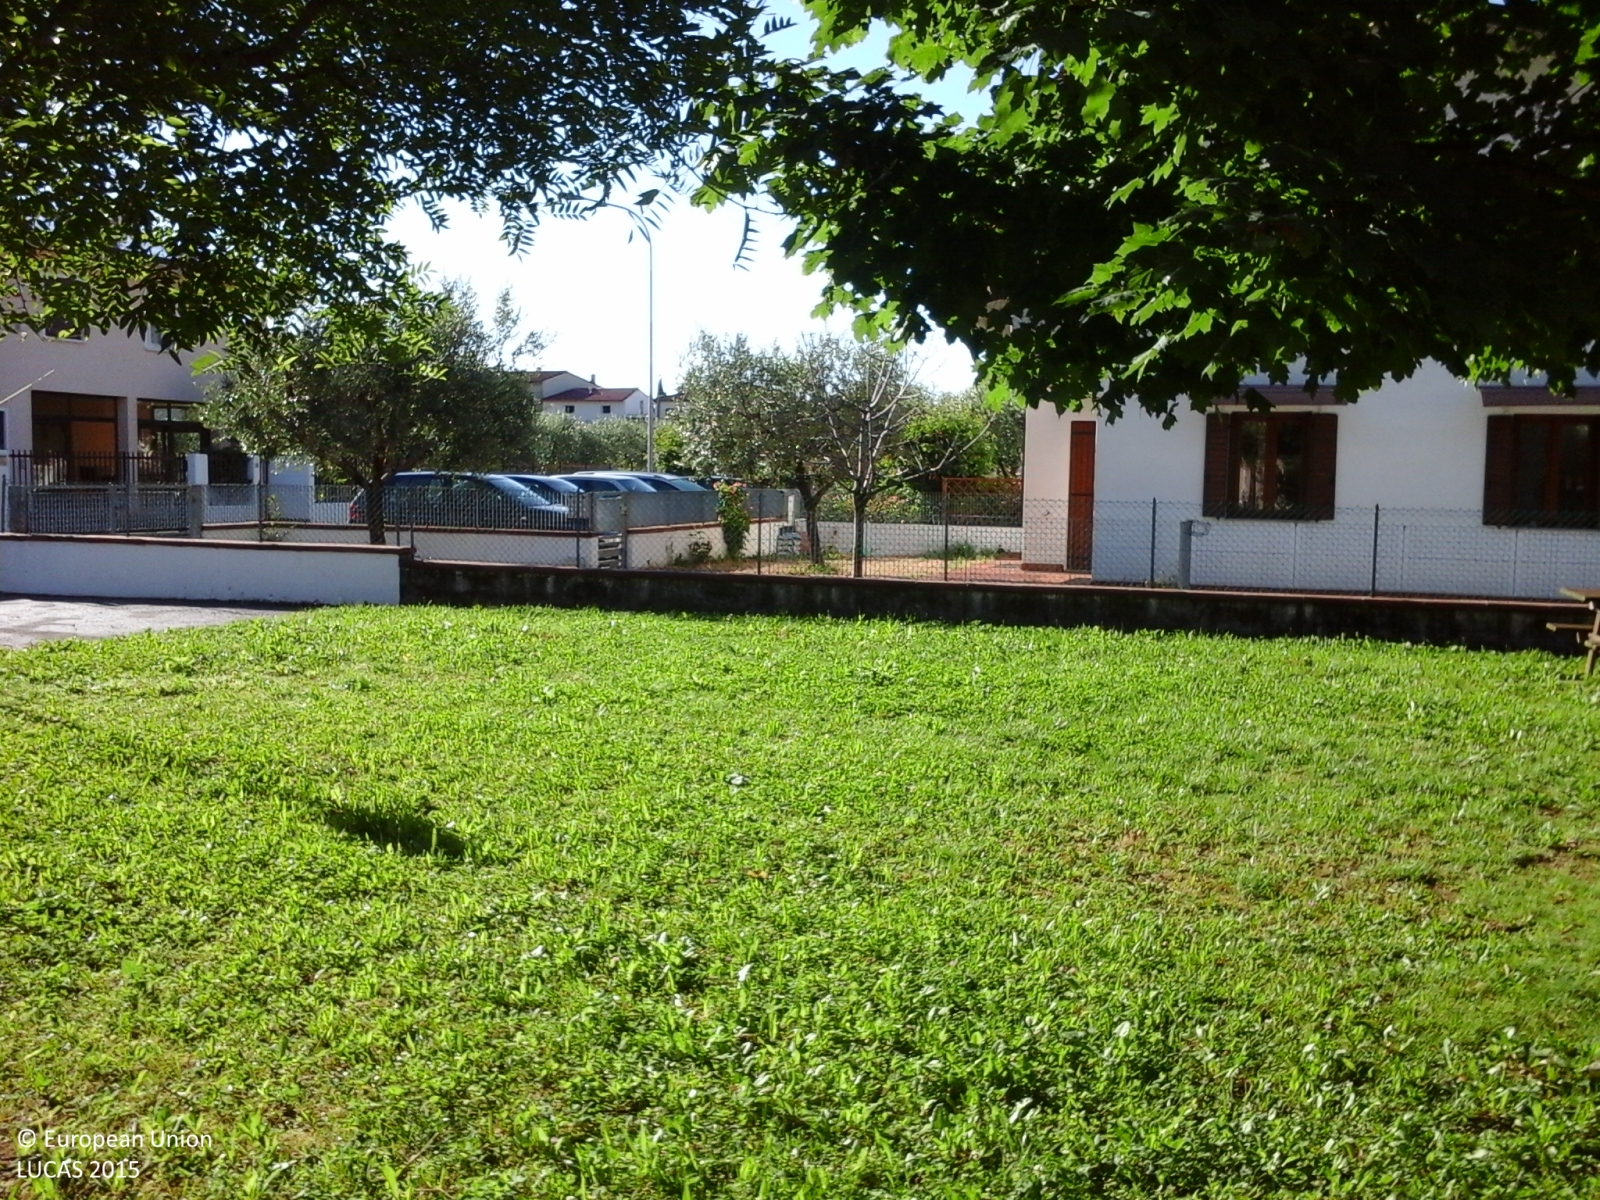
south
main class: Grassland
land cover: Grassland with sparse tree/shrub cover
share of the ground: > 75 %
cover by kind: herbaceous plants 95 %, broadleaved forest trees 5 %
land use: Amenities, museums, leisure
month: June
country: IT
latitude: 45.7966
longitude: 11.7342
